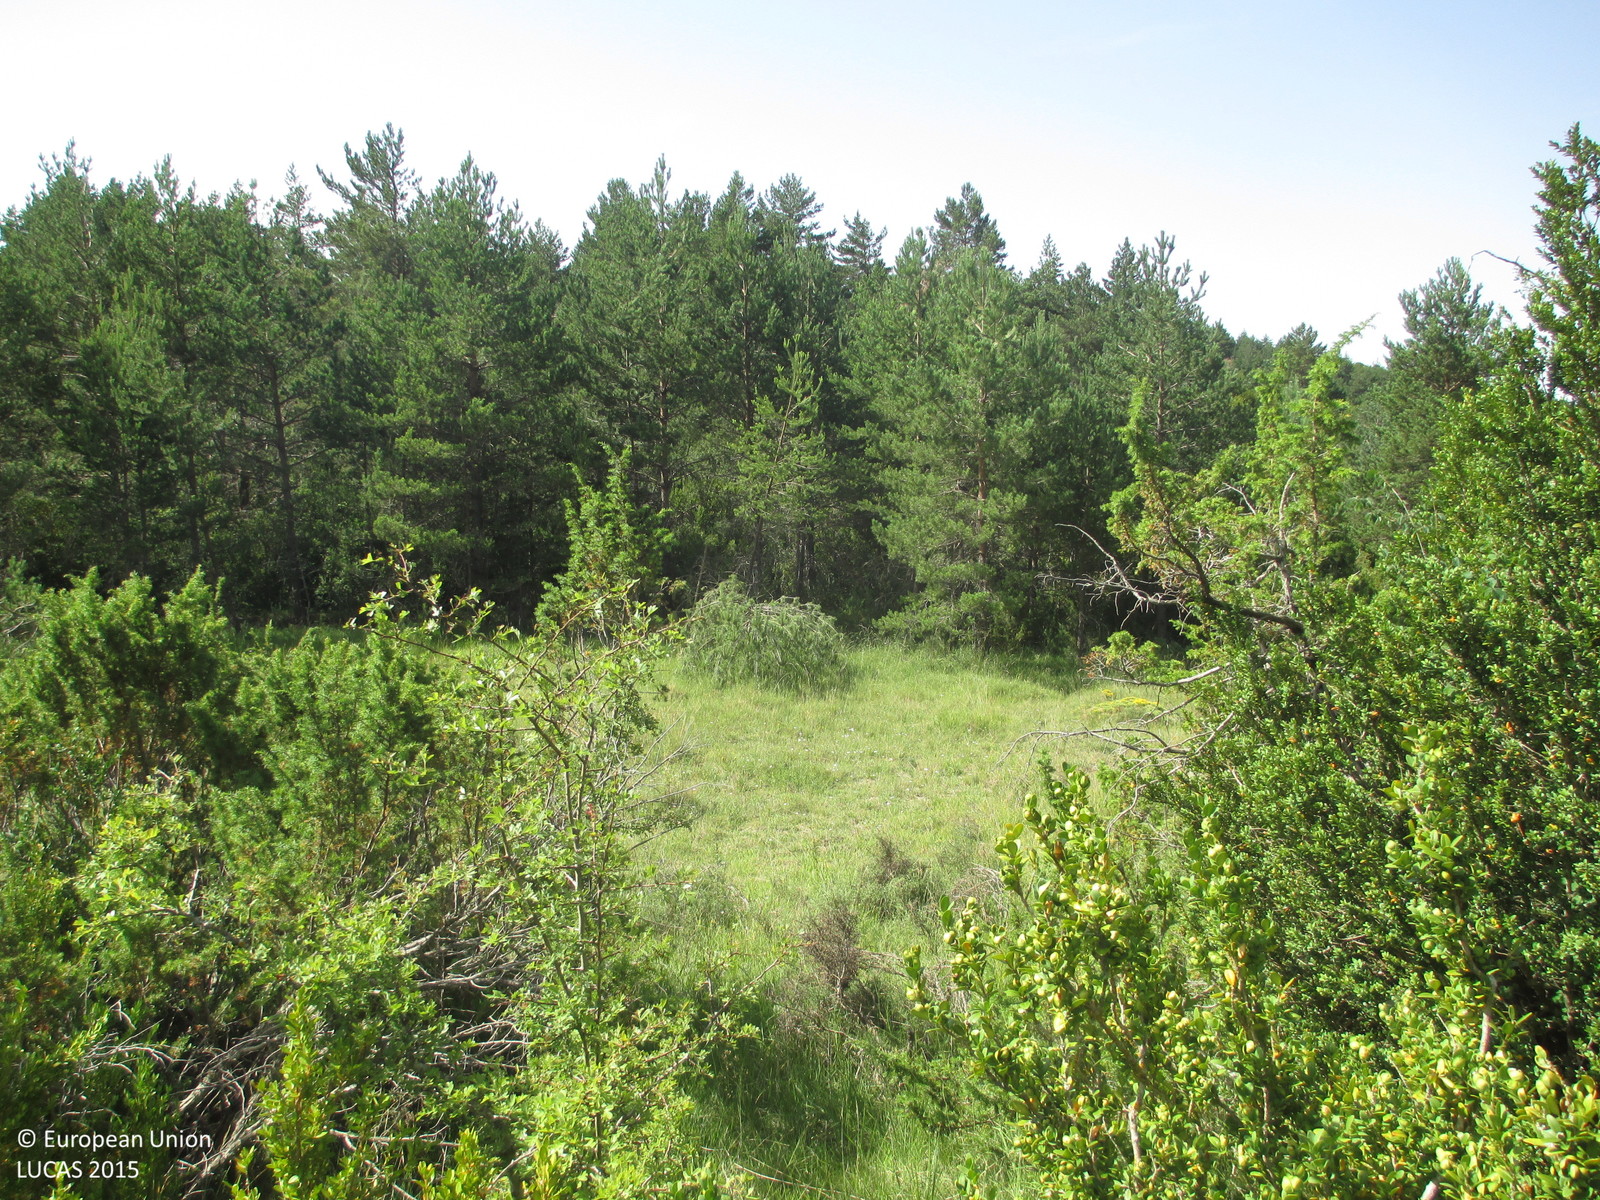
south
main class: Shrubland
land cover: Shrubland with sparse tree cover
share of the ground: > 75 %
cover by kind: shrubs 85 %, coniferous forest trees 5 %, herbaceous plants 5 %, consolidated bare surface 5 %
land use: Semi-natural and natural areas not in use
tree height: > 5 m
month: July
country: ES
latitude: 42.3558
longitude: -0.3801
